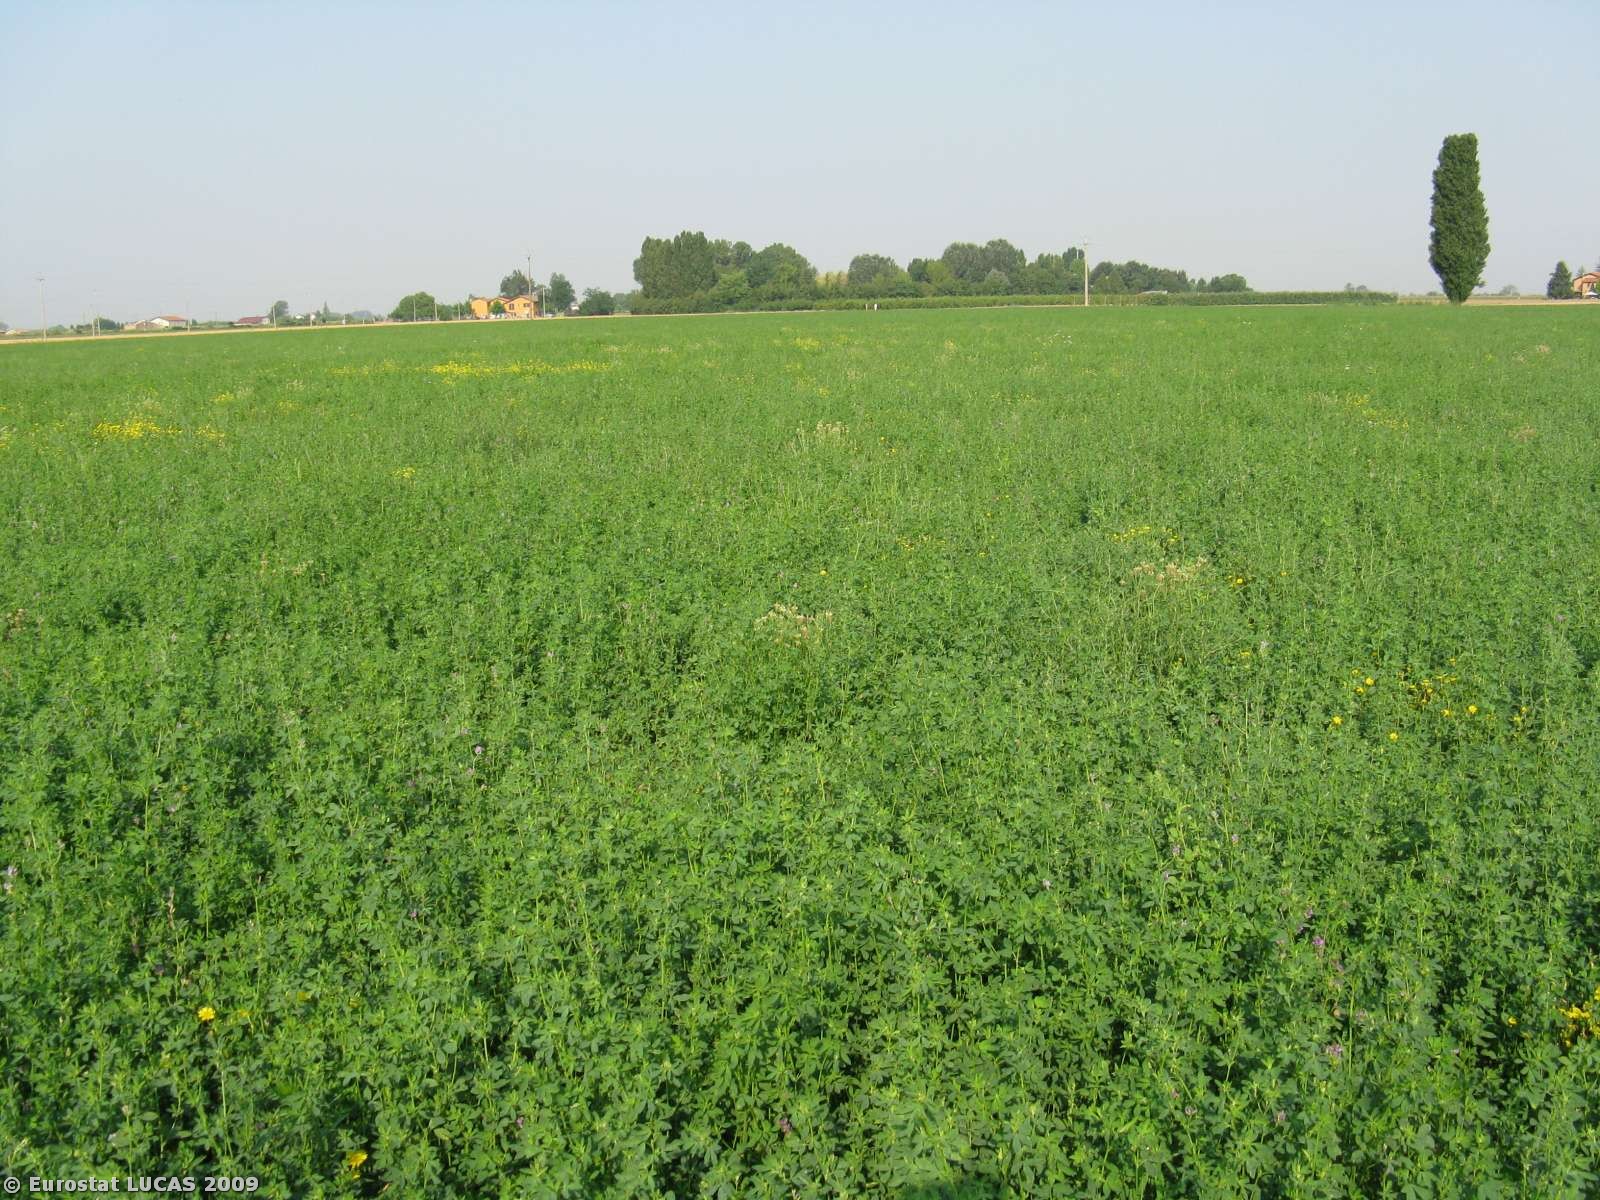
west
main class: Cropland
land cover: Lucerne
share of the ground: > 75 %
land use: Agriculture (excluding fallow land and kitchen gardens)
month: July
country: IT
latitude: 44.5900
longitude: 11.6467
